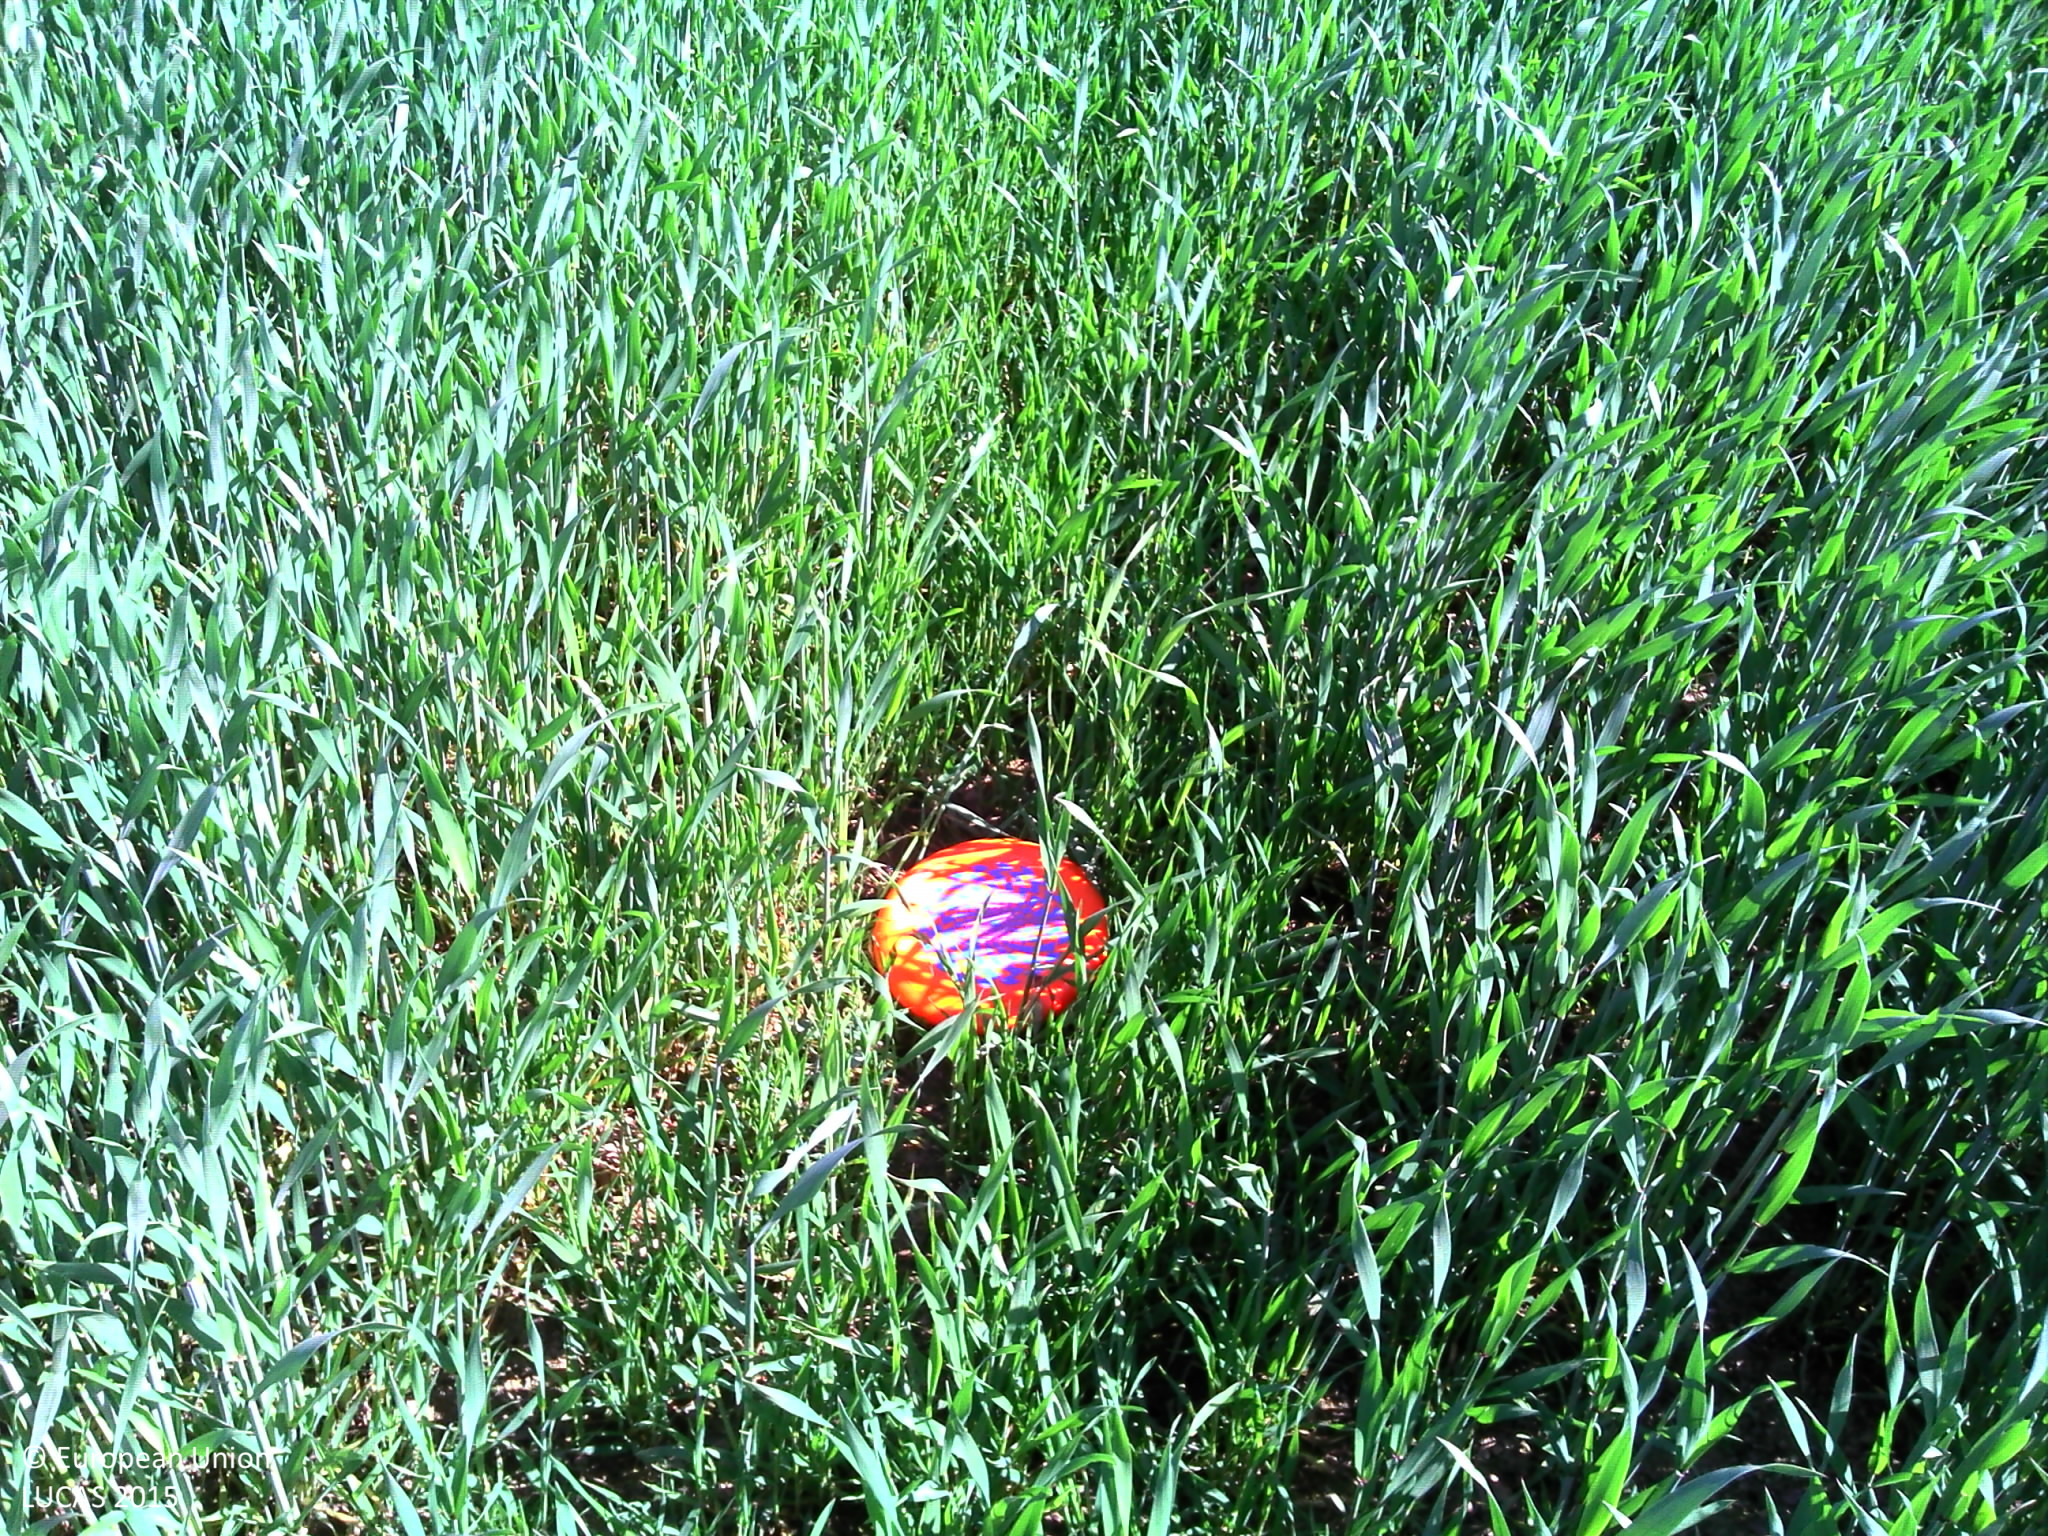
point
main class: Cropland
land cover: Common wheat
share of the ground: > 75 %
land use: Agriculture (excluding fallow land and kitchen gardens)
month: May
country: LU
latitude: 50.0438
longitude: 6.0474
